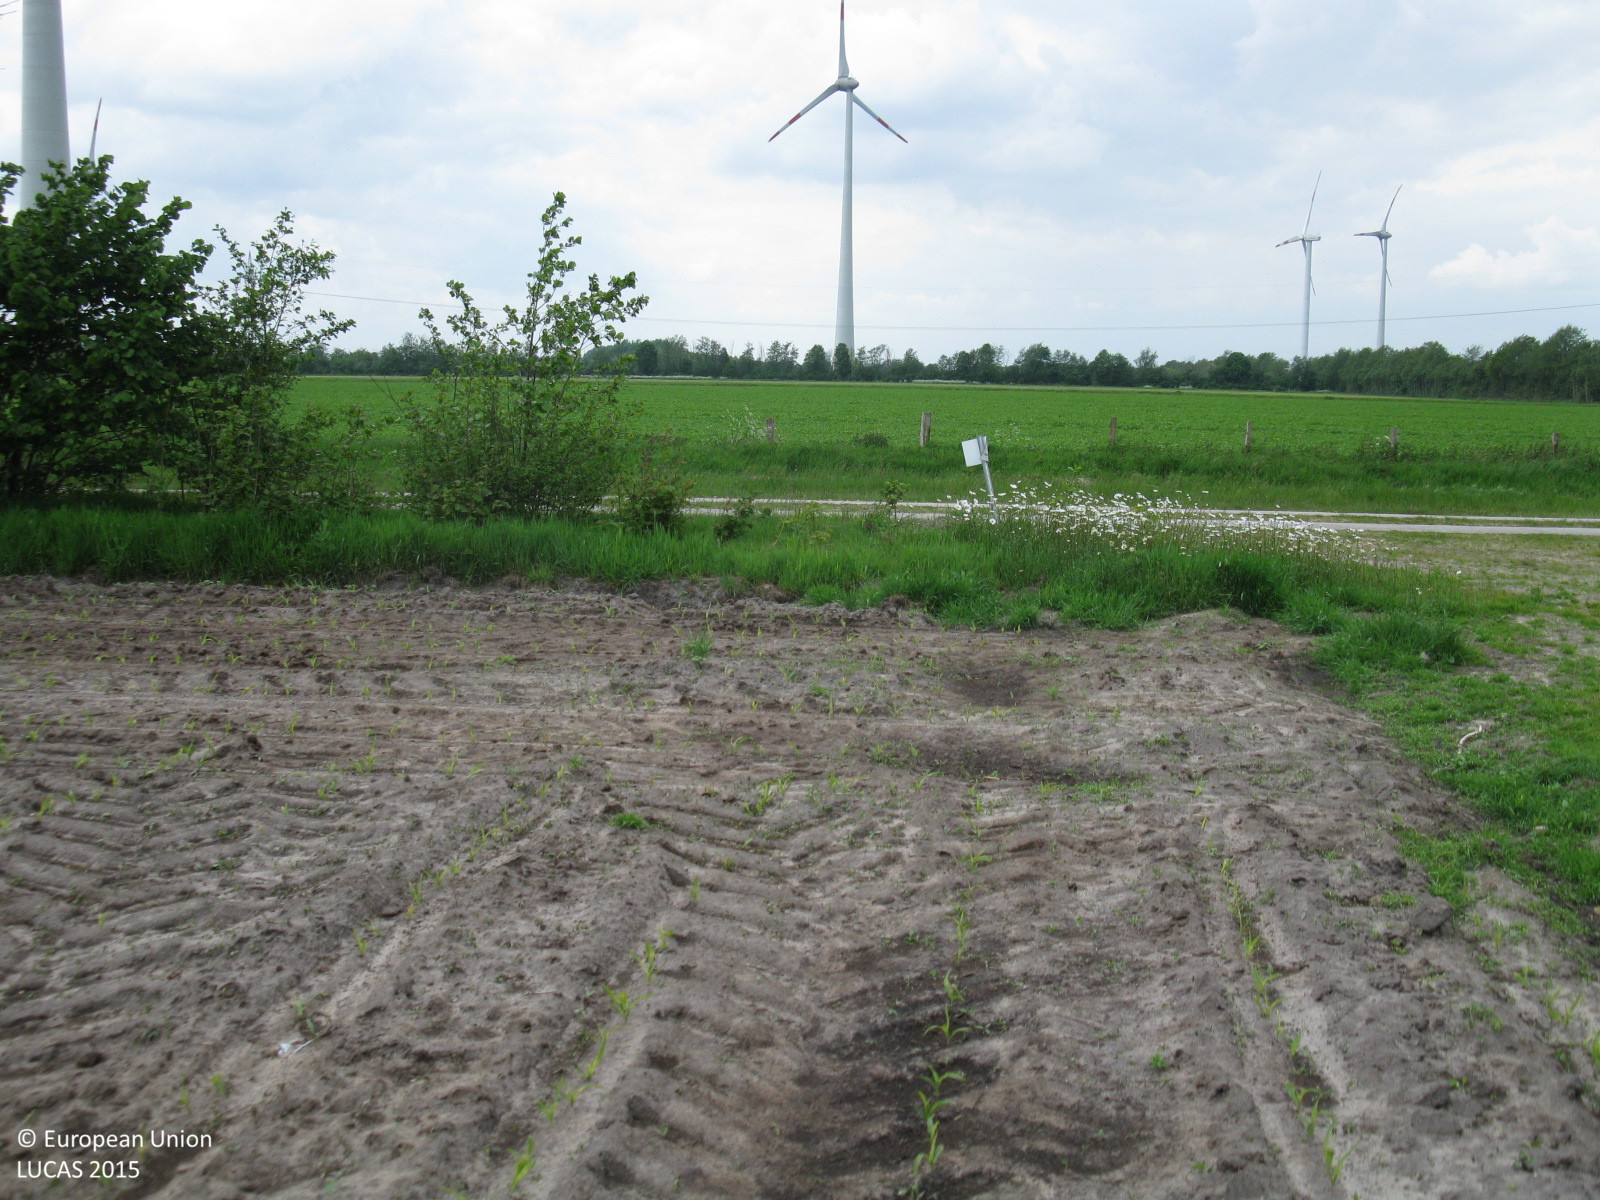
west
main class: Cropland
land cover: Maize
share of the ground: < 10 %
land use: Agriculture (excluding fallow land and kitchen gardens)
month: May
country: DE
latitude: 52.9789
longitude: 7.4240
